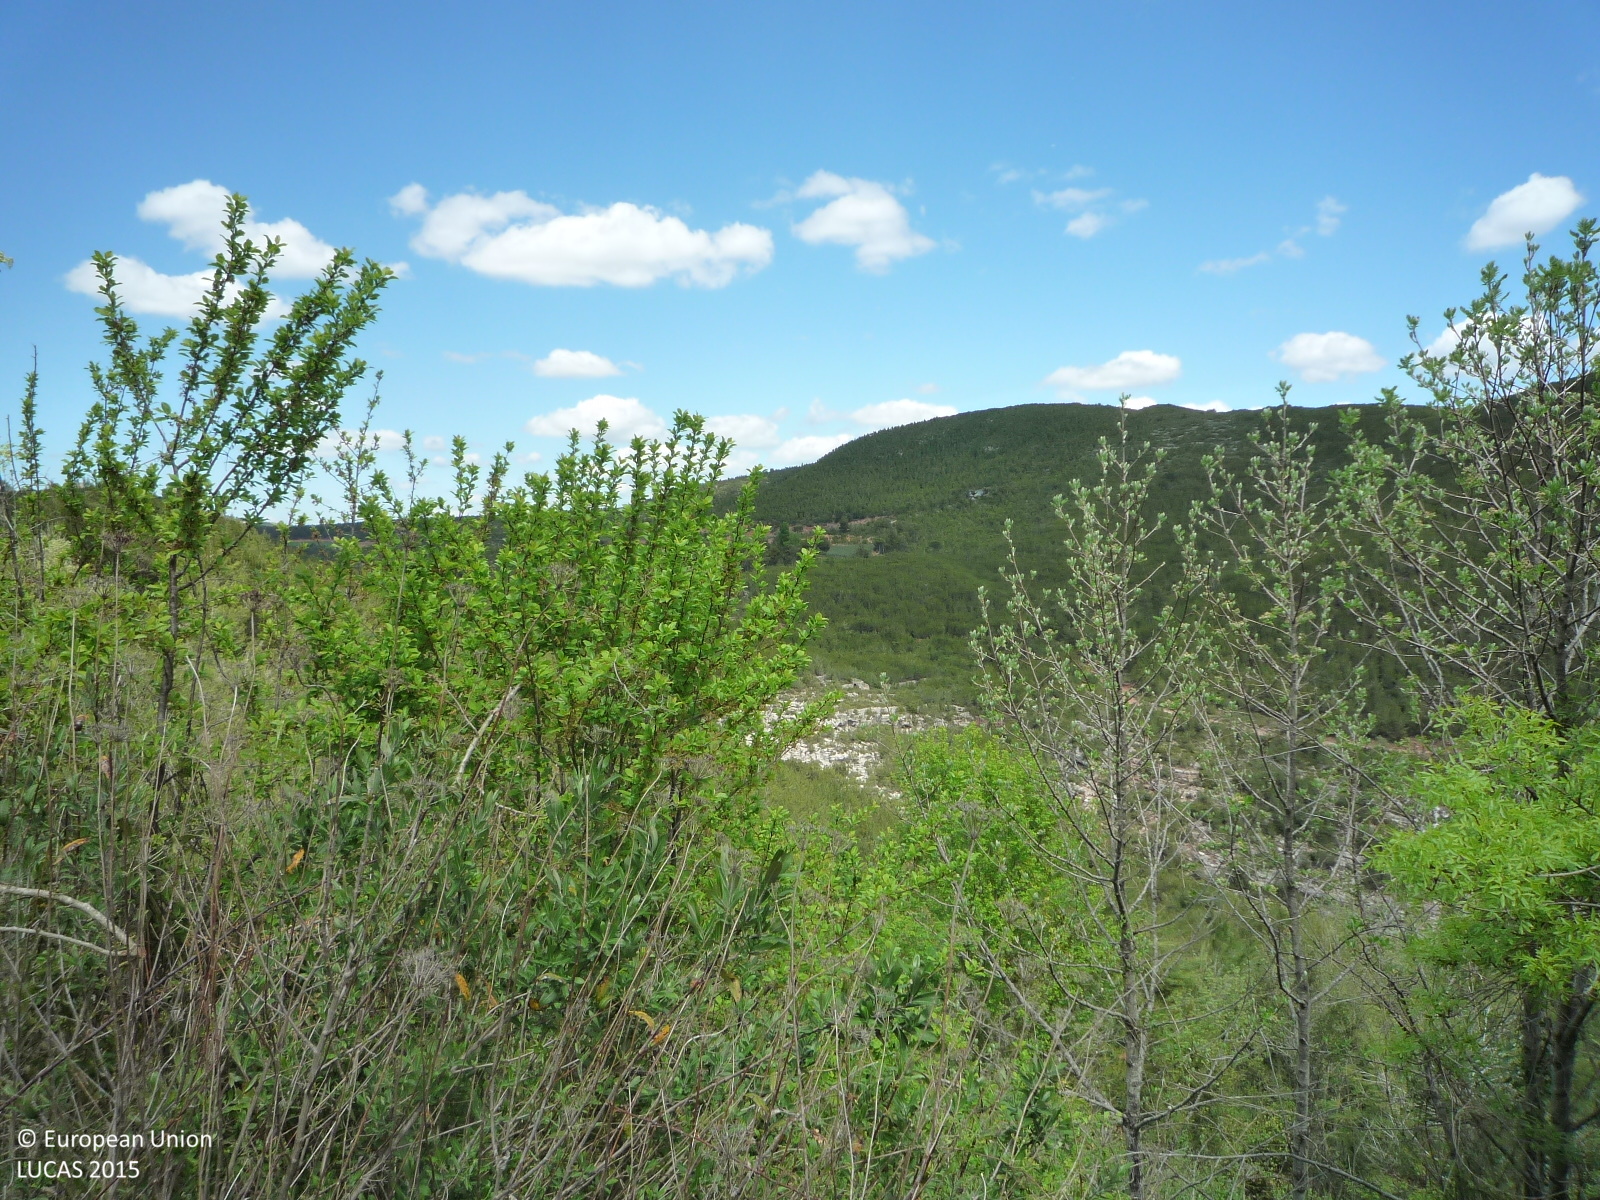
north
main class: Woodland
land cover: Pine dominated coniferous woodland
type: coniferous forest of the mediterranean region
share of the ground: > 75 %
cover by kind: coniferous forest trees 100 %
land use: Semi-natural and natural areas not in use
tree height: < 5 m
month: April
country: ES
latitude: 41.4734
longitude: 1.6462
